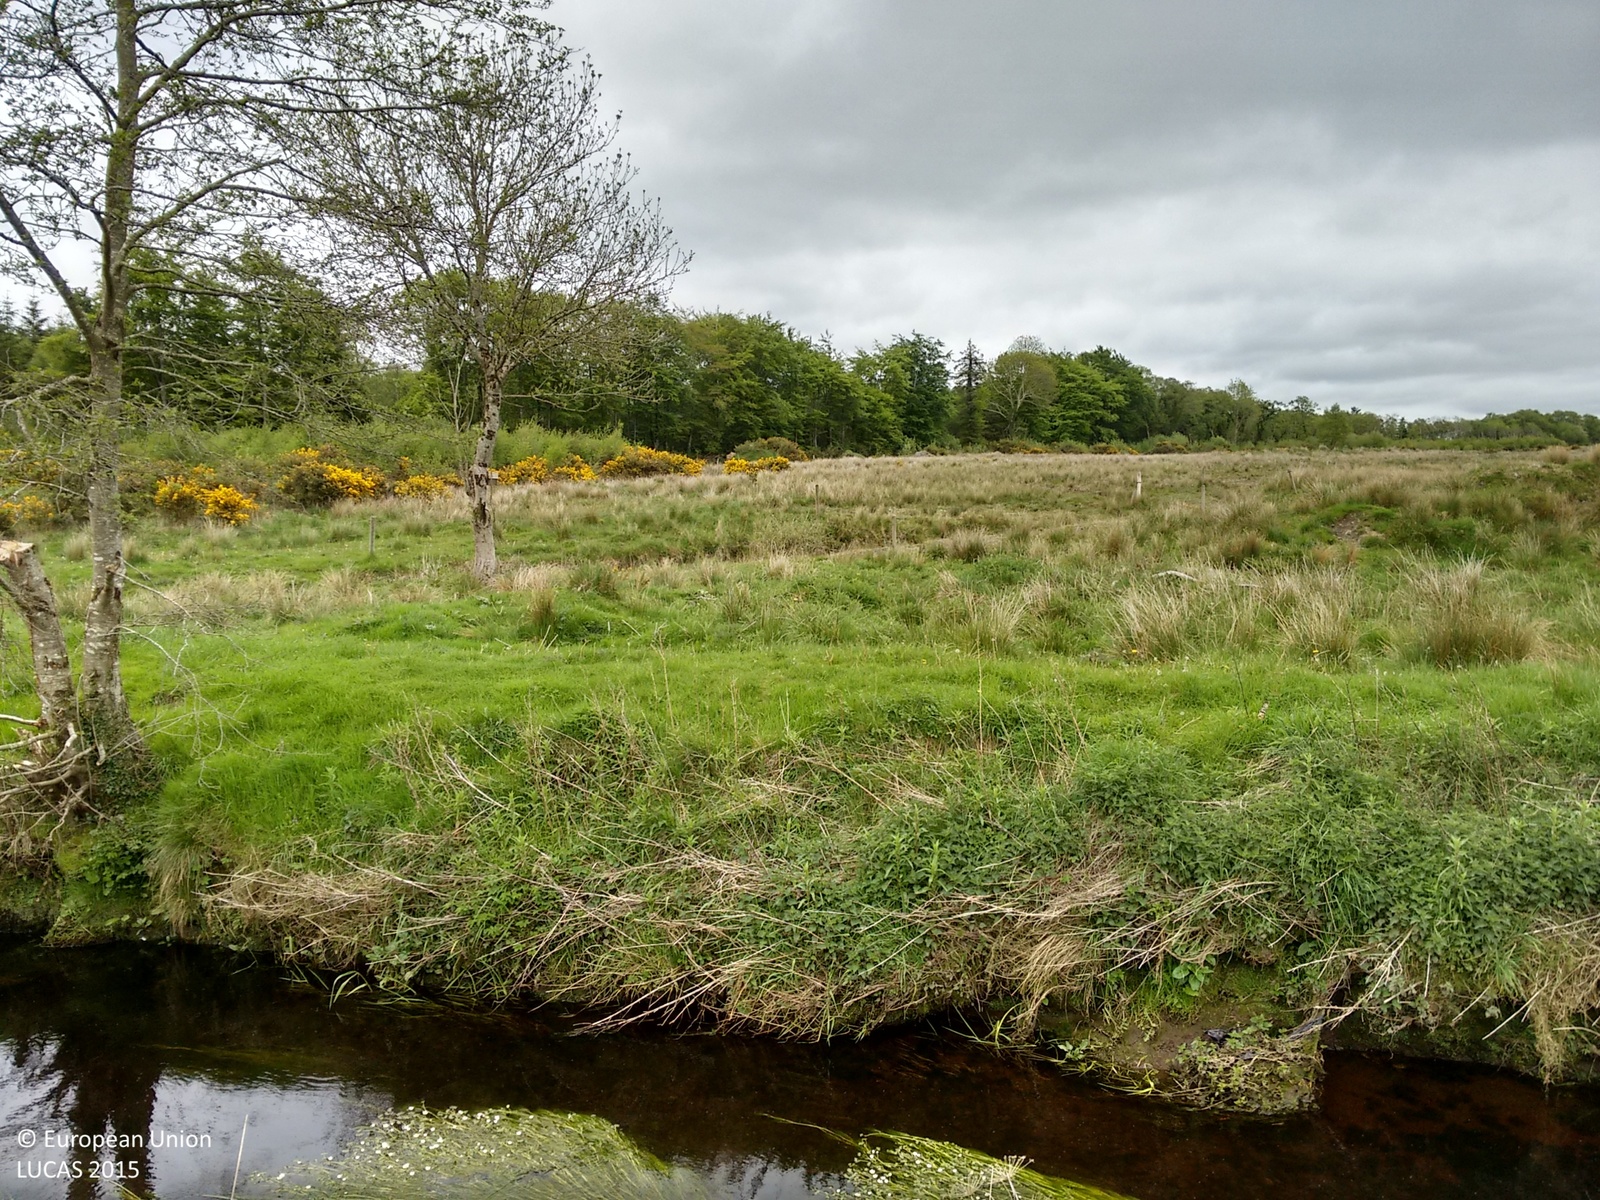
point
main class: Grassland
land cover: Grassland with sparse tree/shrub cover
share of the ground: > 75 %
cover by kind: herbaceous plants 85 %, shrubs 10 %, broadleaved forest trees 5 %
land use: Agriculture (excluding fallow land and kitchen gardens)
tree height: < 5 m
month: May
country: IE
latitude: 53.3723
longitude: -8.6721
